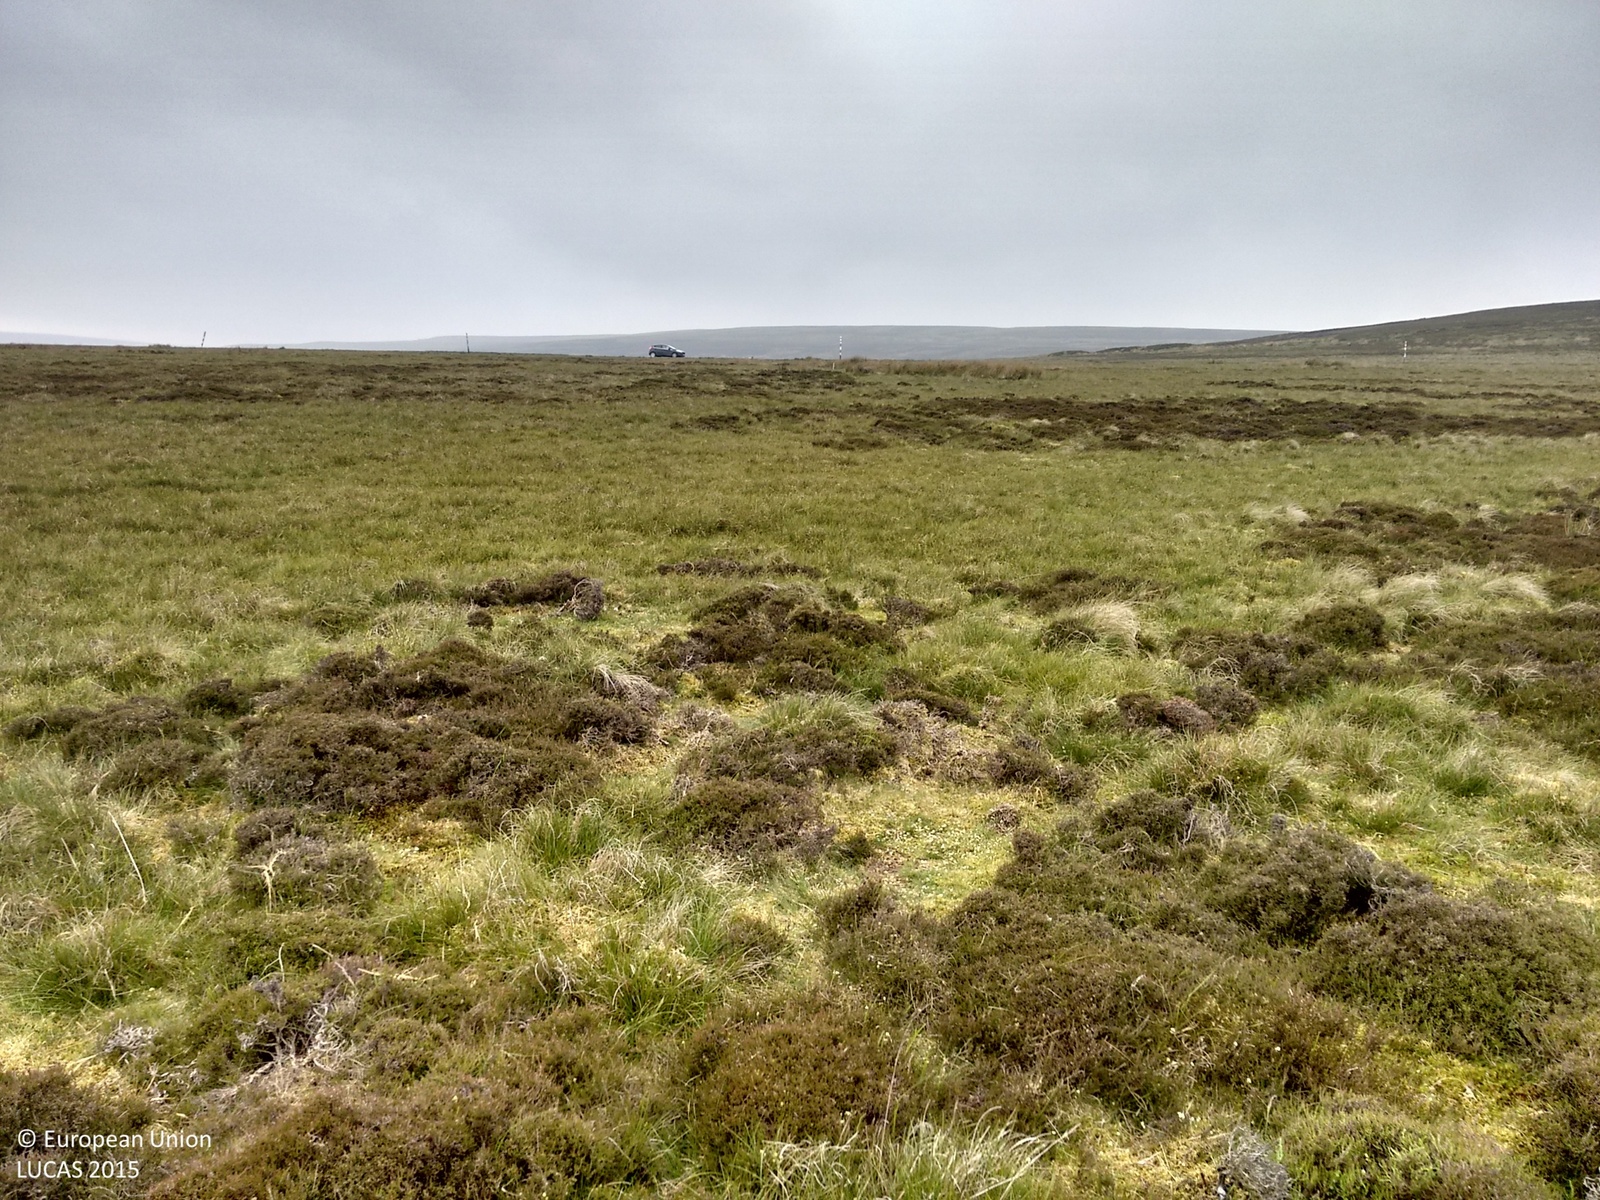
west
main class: Shrubland
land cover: Shrubland without tree cover
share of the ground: > 75 %
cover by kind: shrubs 80 %, herbaceous plants 20 %
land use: Agriculture (excluding fallow land and kitchen gardens)
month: June
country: GB
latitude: 54.7926
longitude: -2.1102
